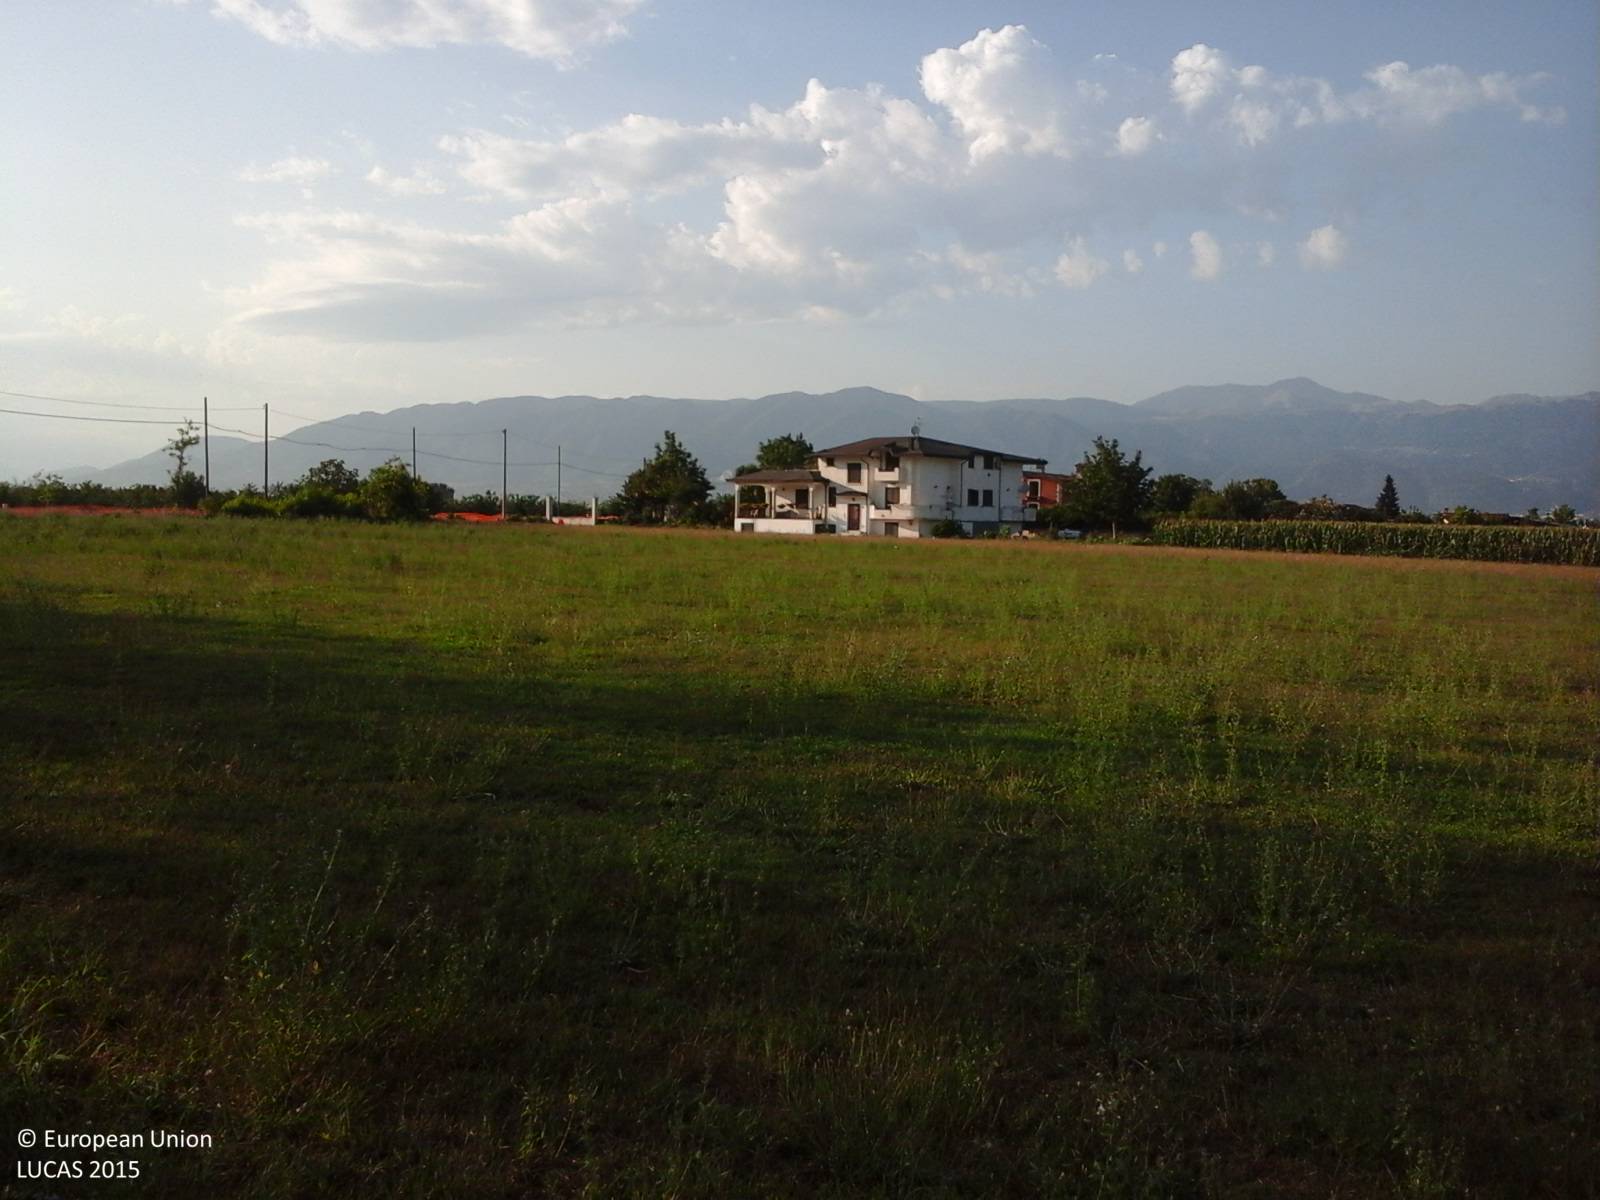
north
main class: Cropland
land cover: Lucerne
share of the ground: > 75 %
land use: Agriculture (excluding fallow land and kitchen gardens)
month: July
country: IT
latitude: 41.2582
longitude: 14.3398
